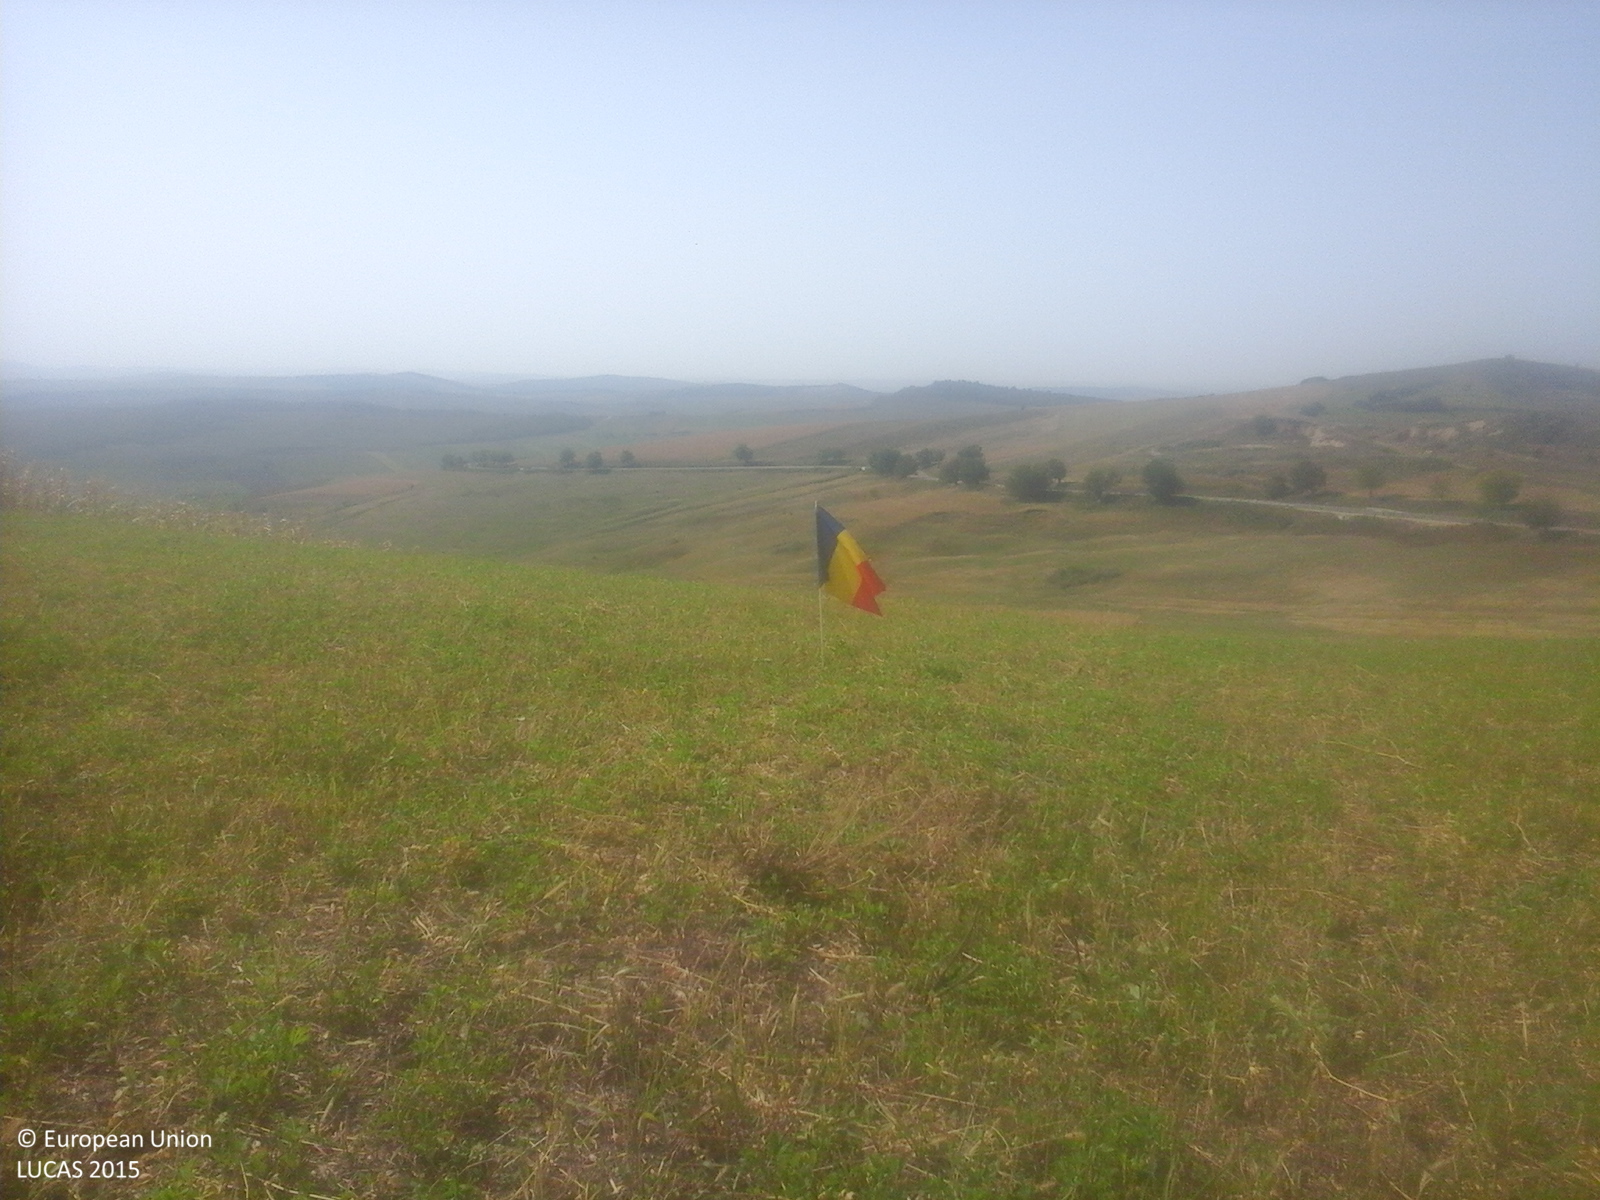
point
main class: Cropland
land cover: Lucerne
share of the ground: > 75 %
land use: Agriculture (excluding fallow land and kitchen gardens)
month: September
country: RO
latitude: 46.8904
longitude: 24.2455
